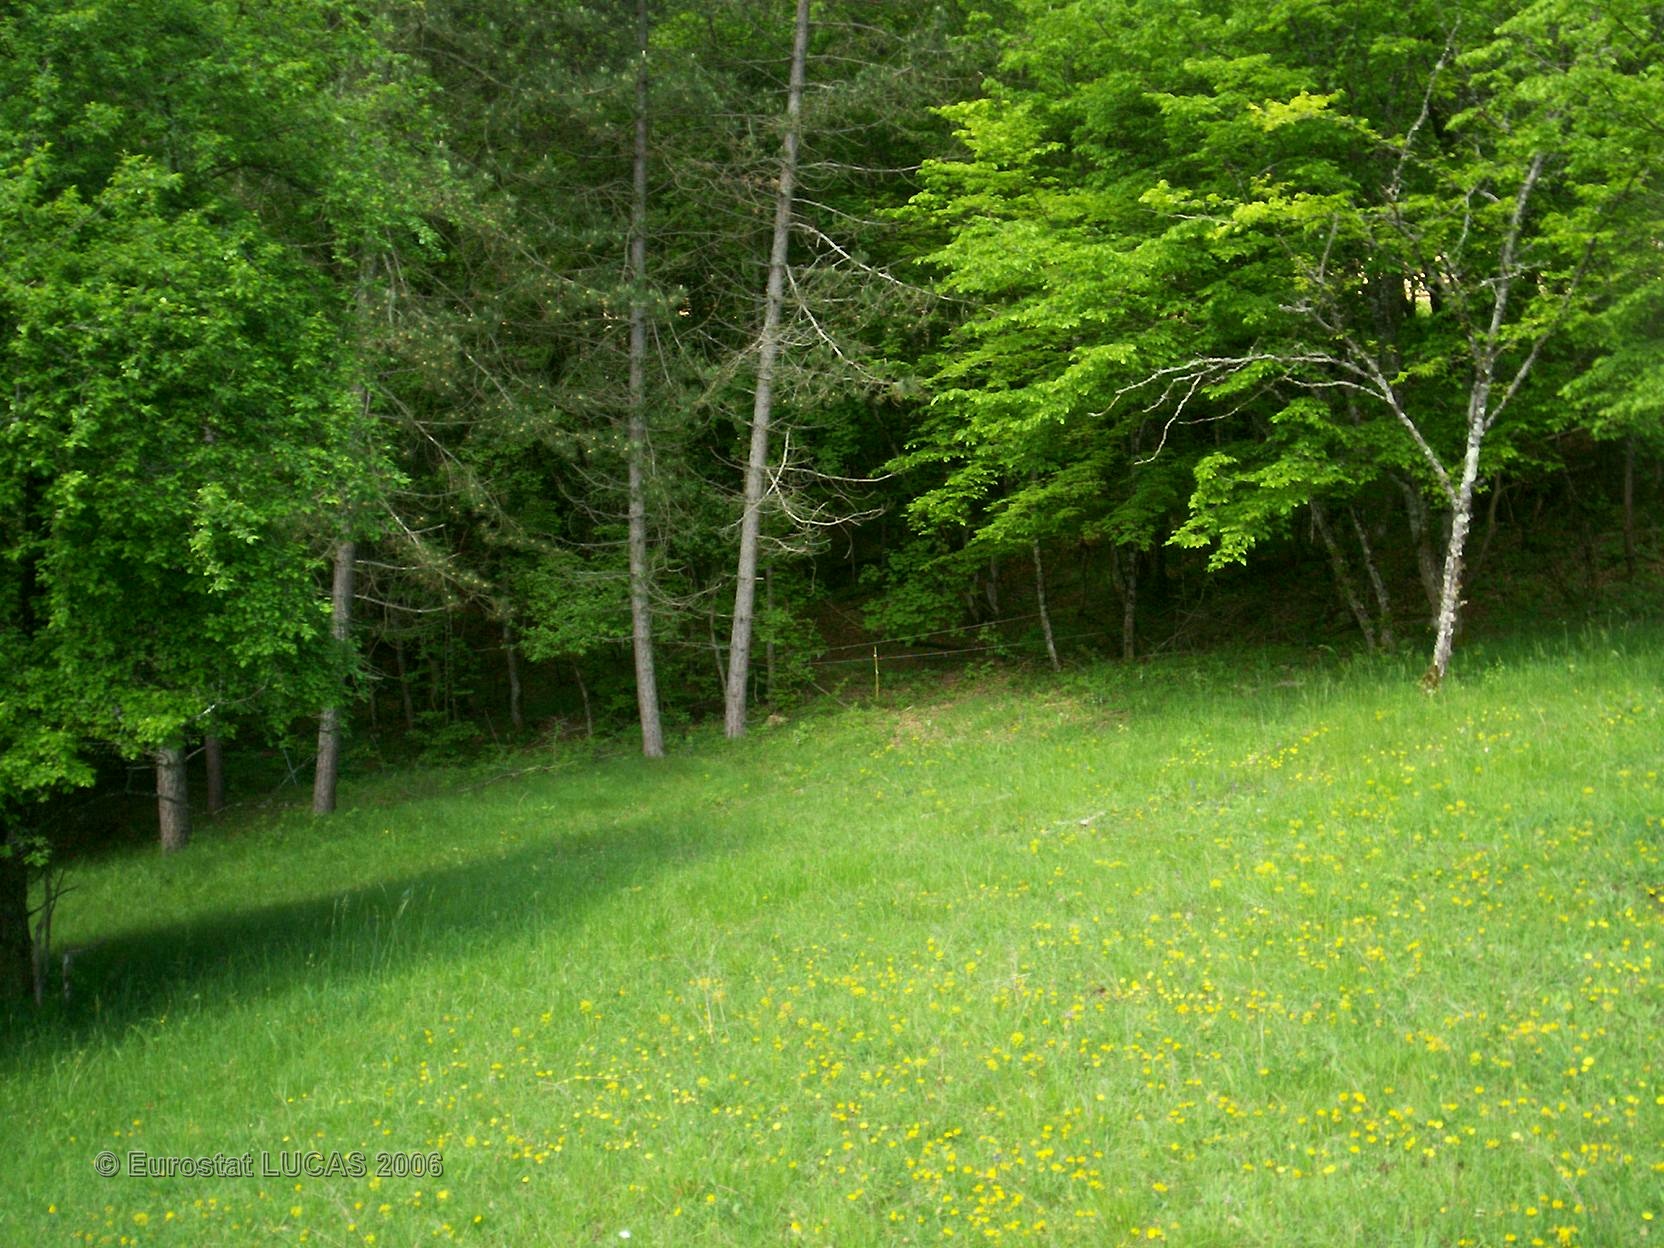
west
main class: Grassland
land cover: Grassland with sparse tree/shrub cover
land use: Agriculture (excluding fallow land and kitchen gardens)
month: May
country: FR
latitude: 47.2318
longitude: 4.7300
